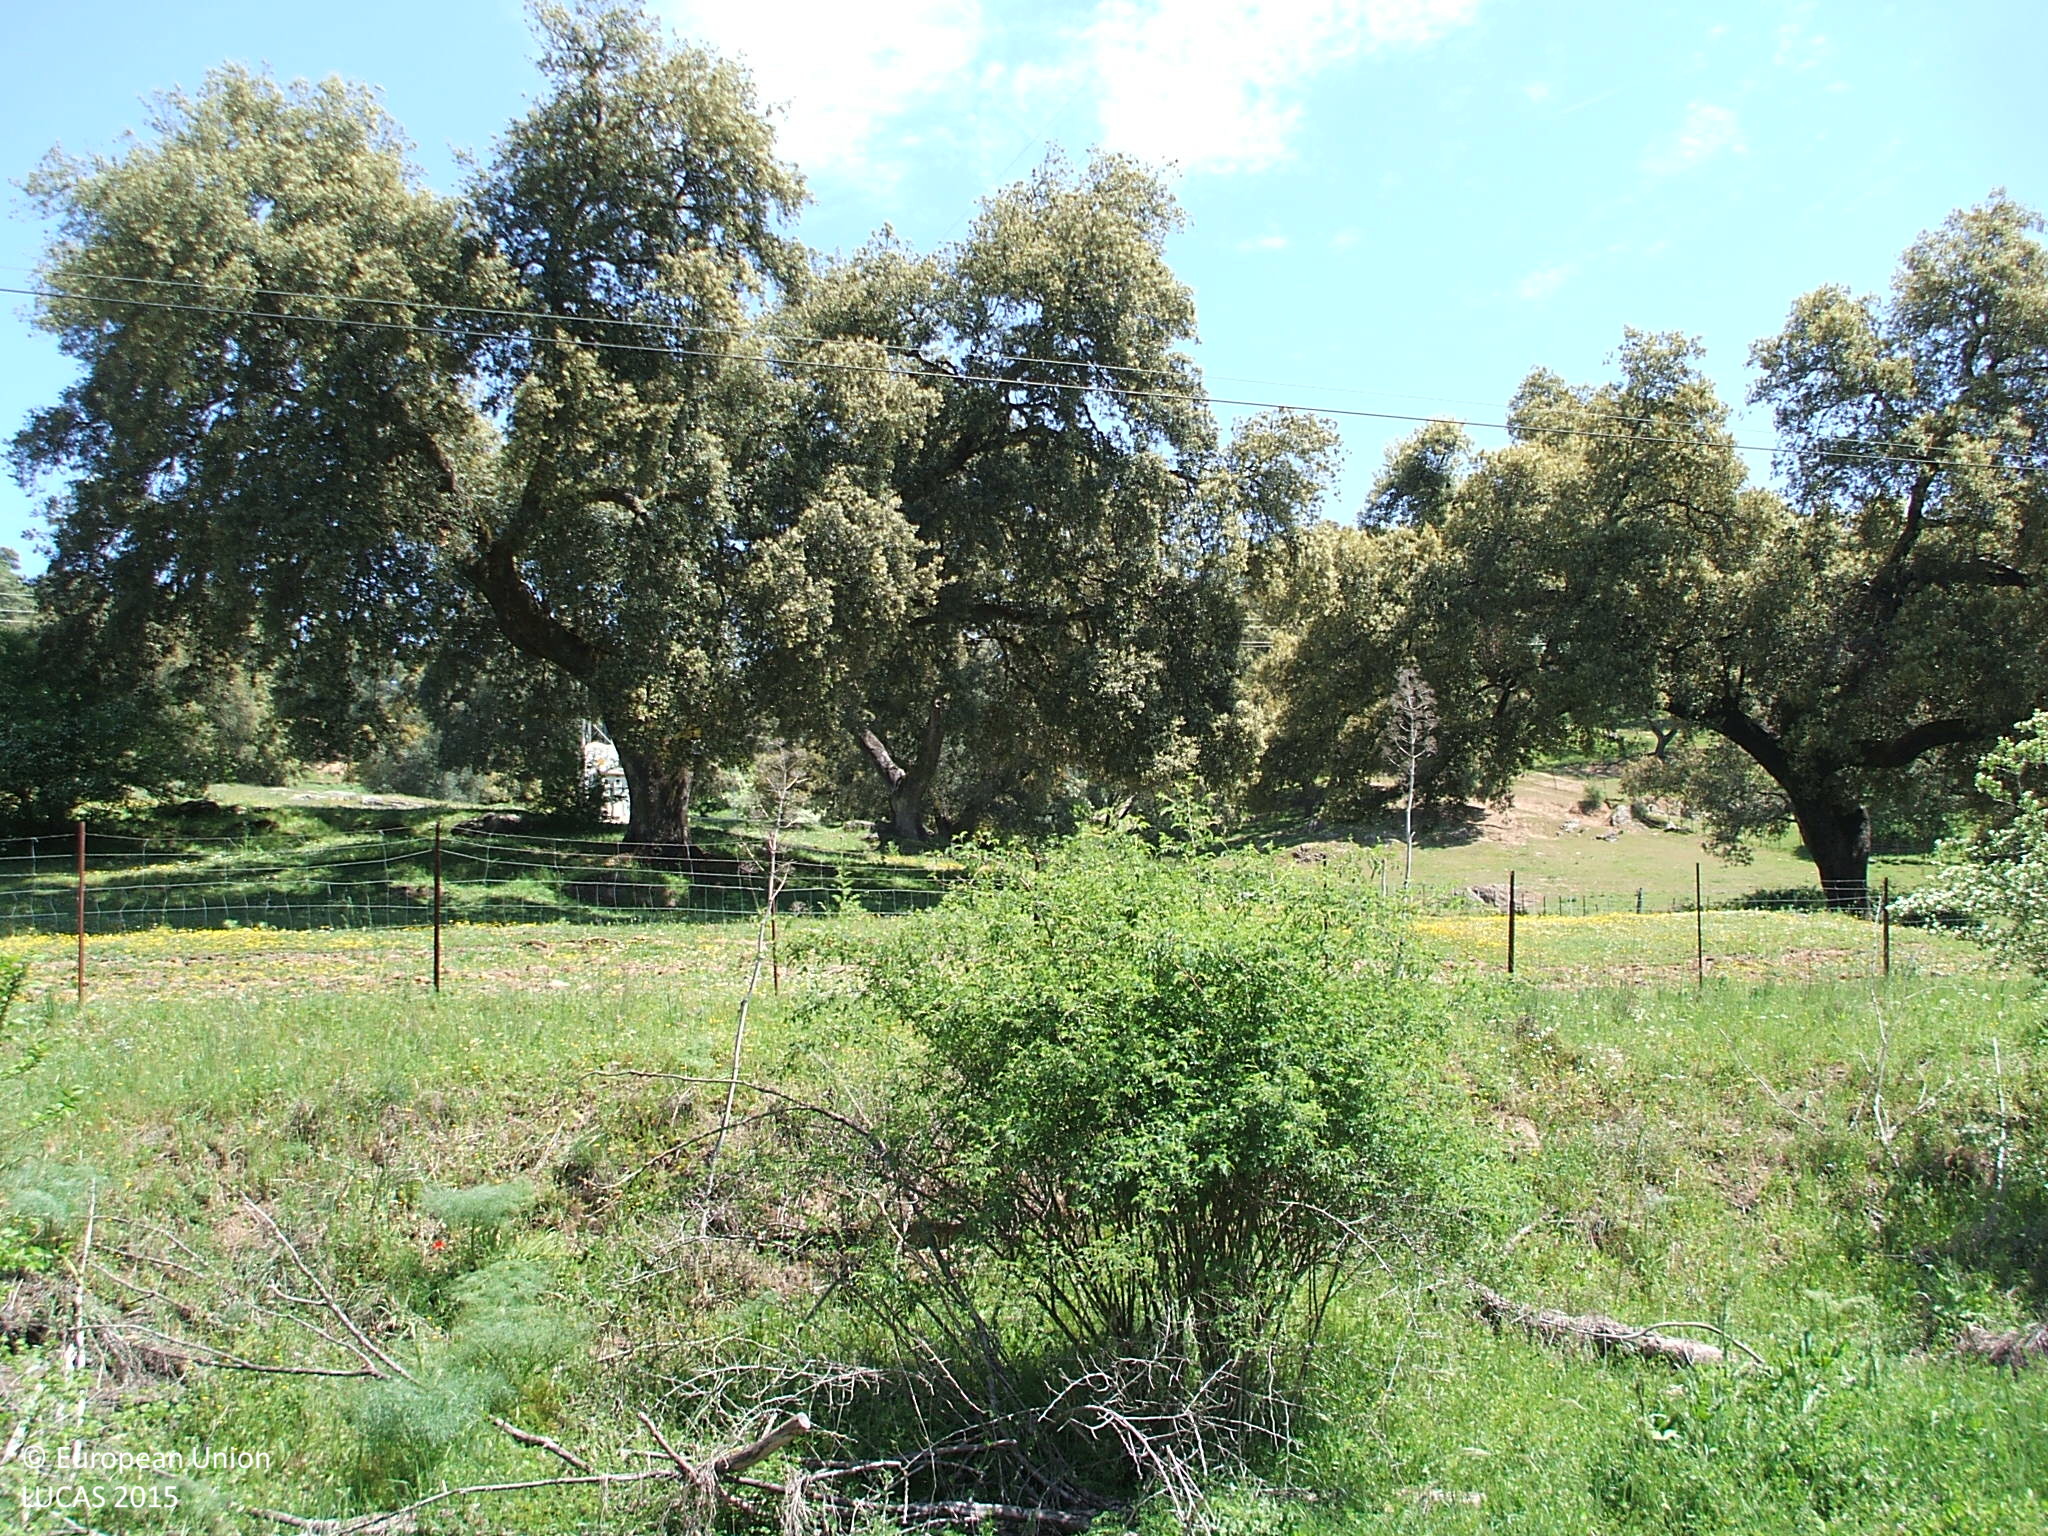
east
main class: Shrubland
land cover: Shrubland with sparse tree cover
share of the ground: > 75 %
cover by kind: shrubs 70 %, herbaceous plants 25 %, broadleaved forest trees 5 %
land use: Agriculture (excluding fallow land and kitchen gardens)
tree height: > 5 m
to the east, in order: Shrubland with sparse tree cover; Electric lines; Shrubland with sparse tree cover; Grassland with sparse tree/shrub cover; Electric lines; Grassland with sparse tree/shrub cover; Paved roads, cycling and walking lanes; Broadleaved woodland; Fences; Electric lines; Broadleaved woodland; Tracks; Broadleaved woodland
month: April
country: ES
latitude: 37.9279
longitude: -5.6946
